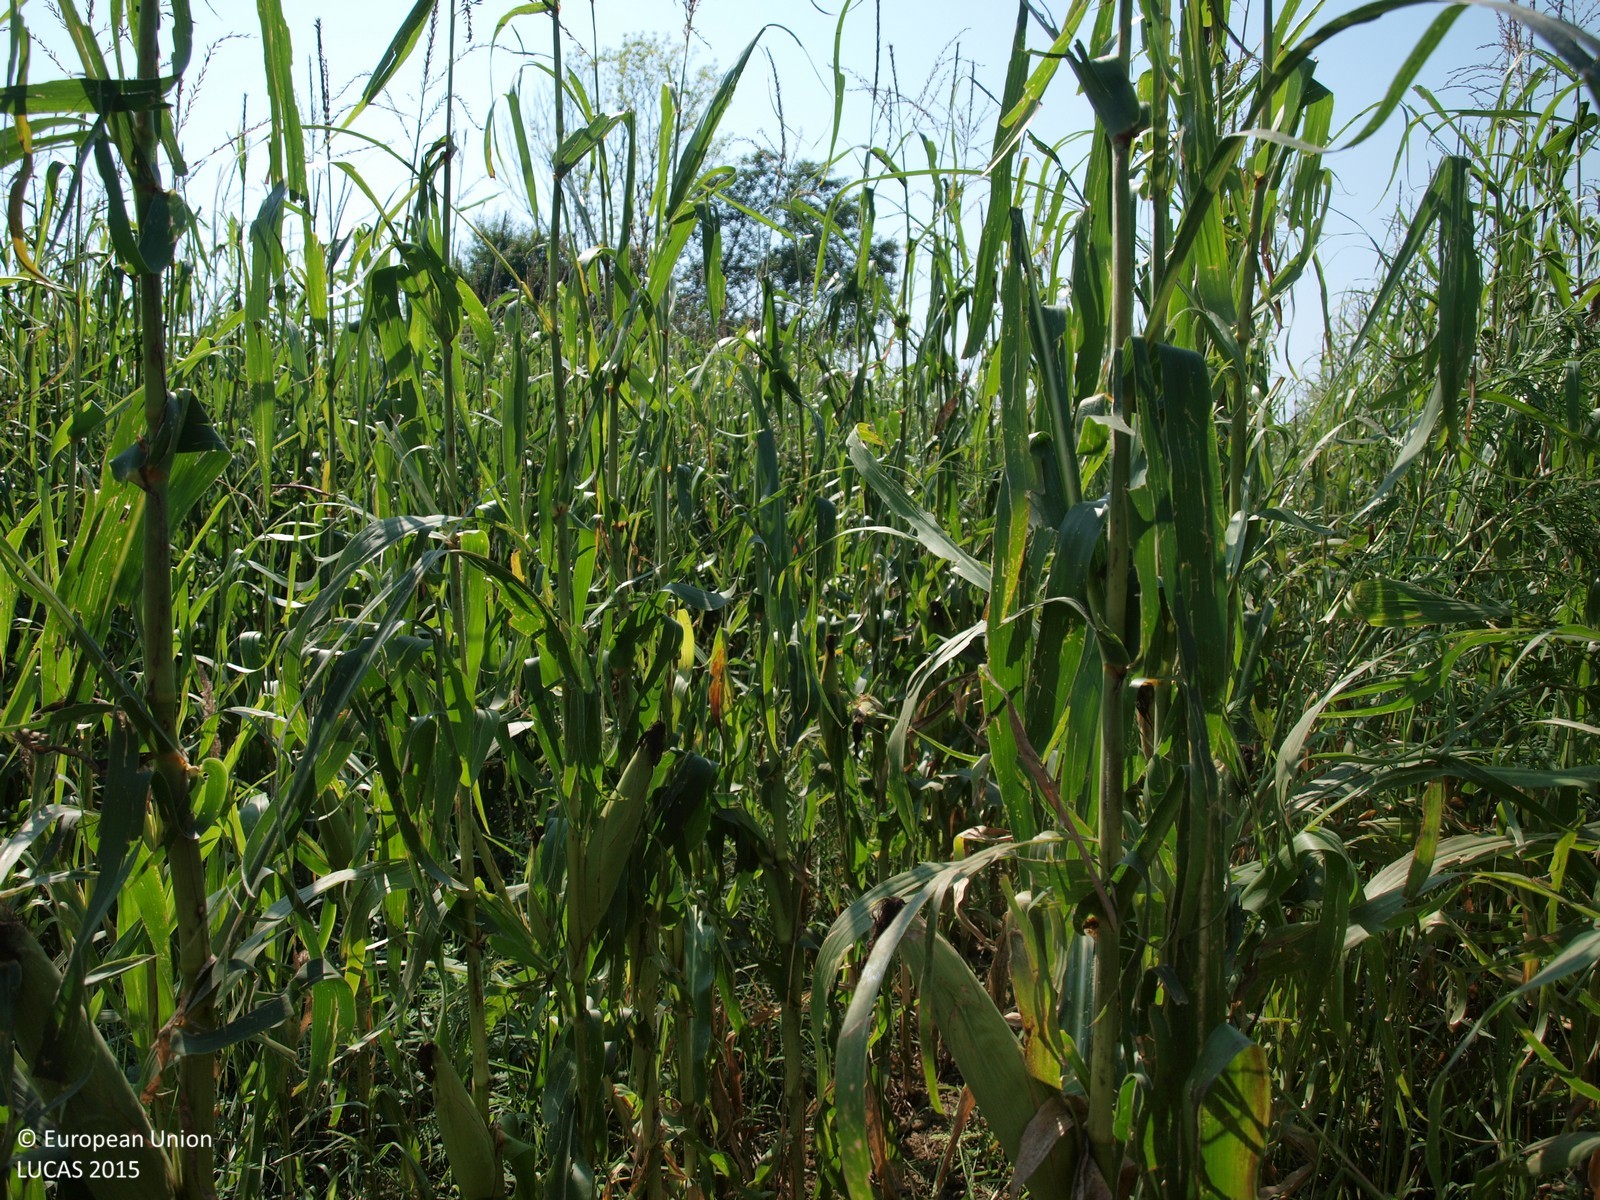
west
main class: Cropland
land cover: Maize
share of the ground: > 75 %
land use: Agriculture (excluding fallow land and kitchen gardens)
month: August
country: HR
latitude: 45.9067
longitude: 16.6903
